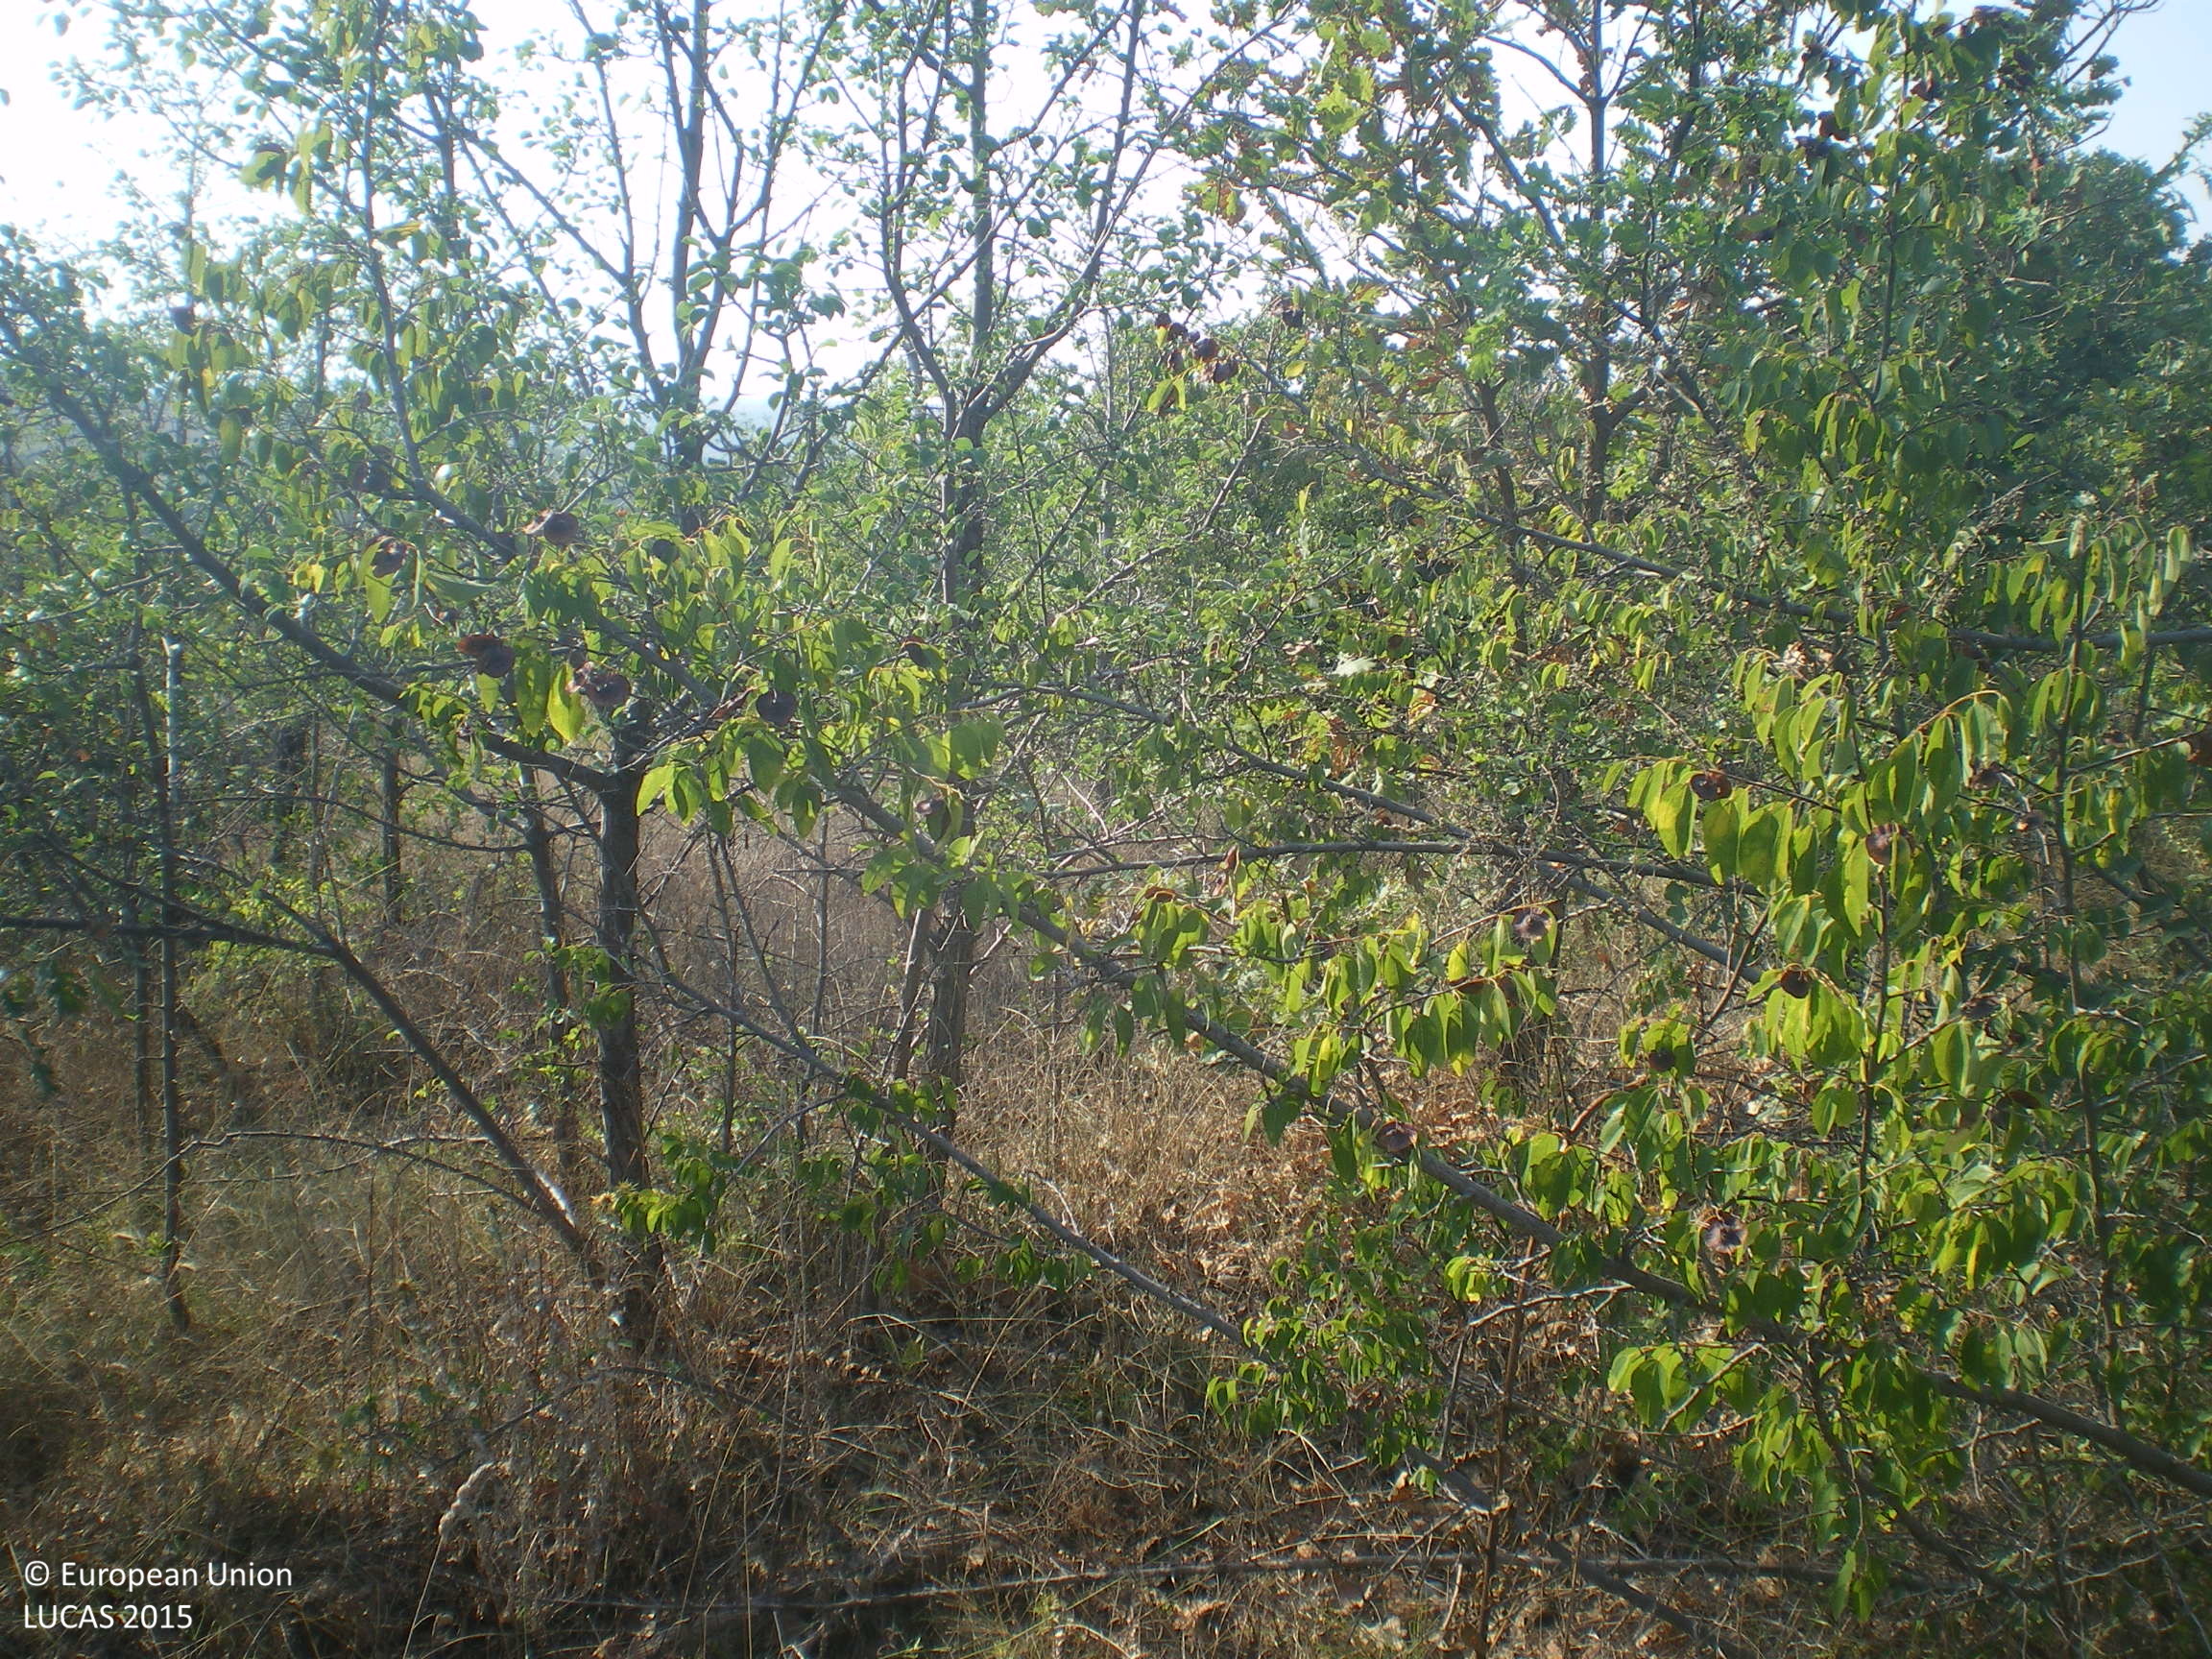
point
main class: Woodland
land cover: Broadleaved woodland
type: acidophilous oak and oak-birch forest
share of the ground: 10 - 25 %
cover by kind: shrubs 80 %, broadleaved forest trees 20 %
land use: Forestry
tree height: > 5 m
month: August
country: BG
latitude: 41.9083
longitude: 25.7522
